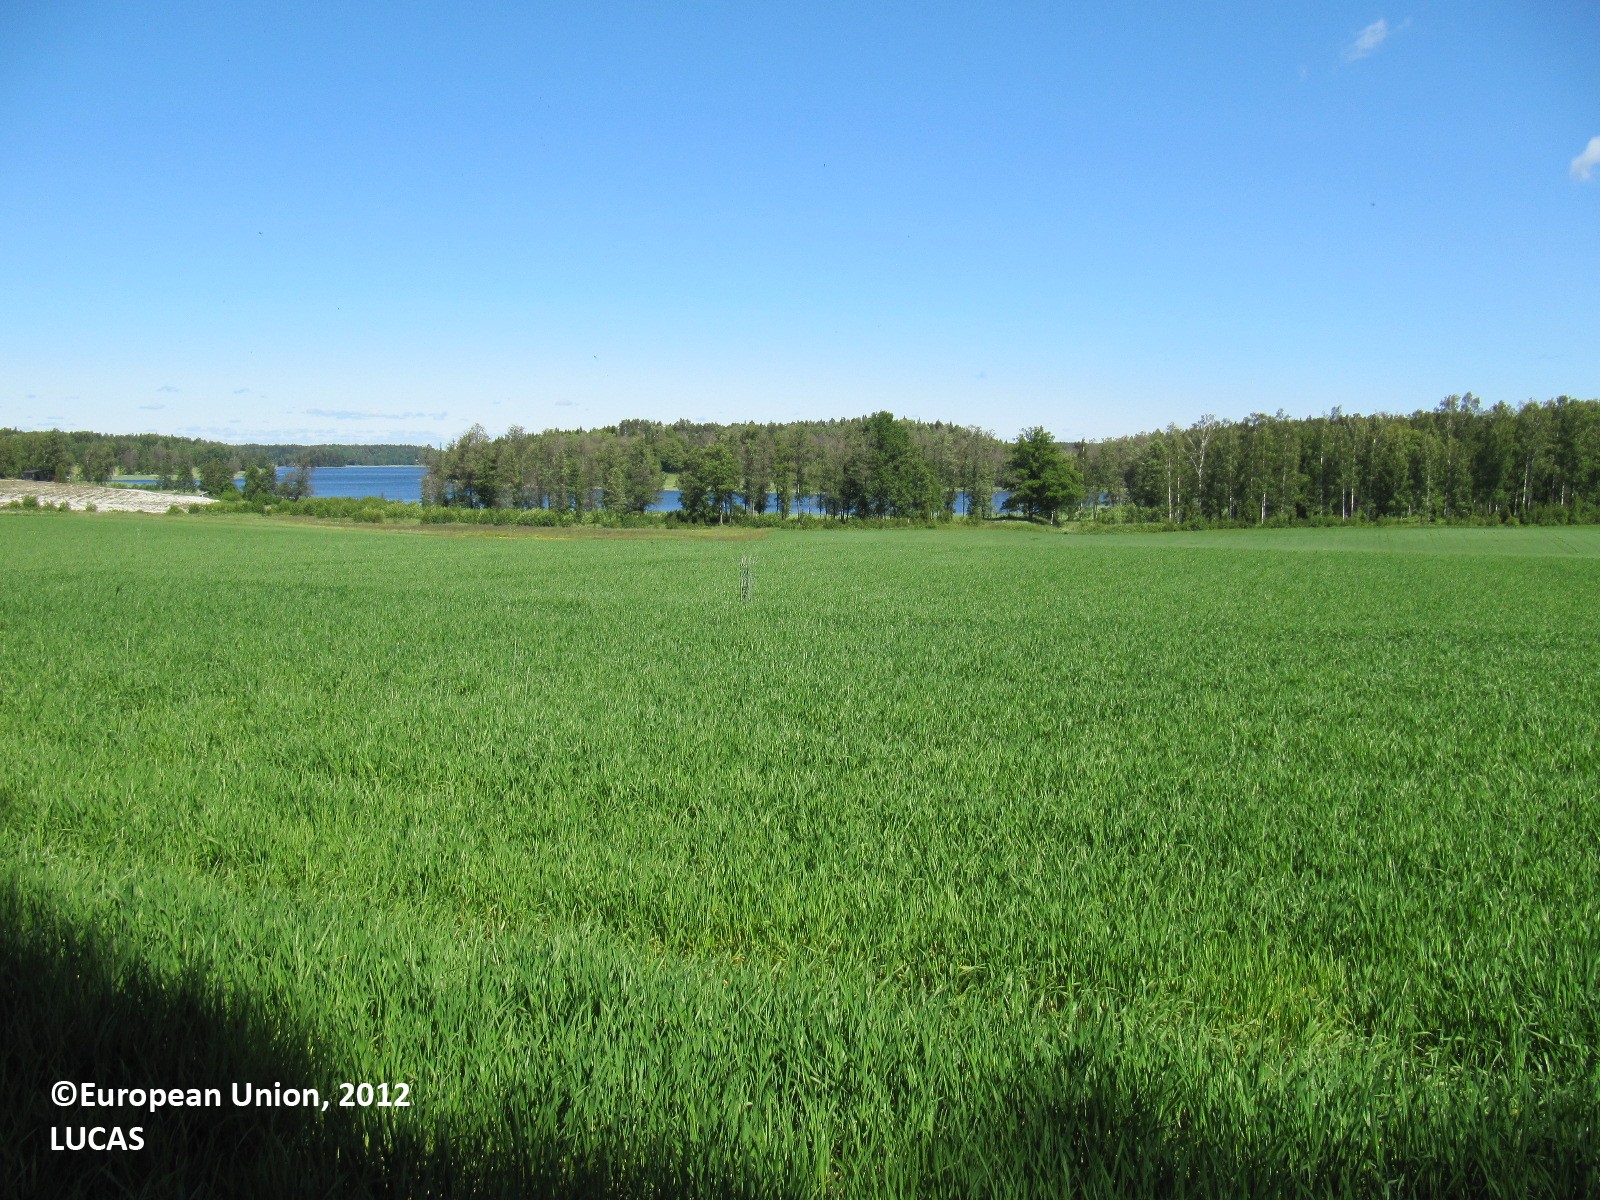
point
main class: Cropland
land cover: Barley
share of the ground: > 75 %
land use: Agriculture (excluding fallow land and kitchen gardens)
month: June
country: FI
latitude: 60.0065
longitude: 23.0846
